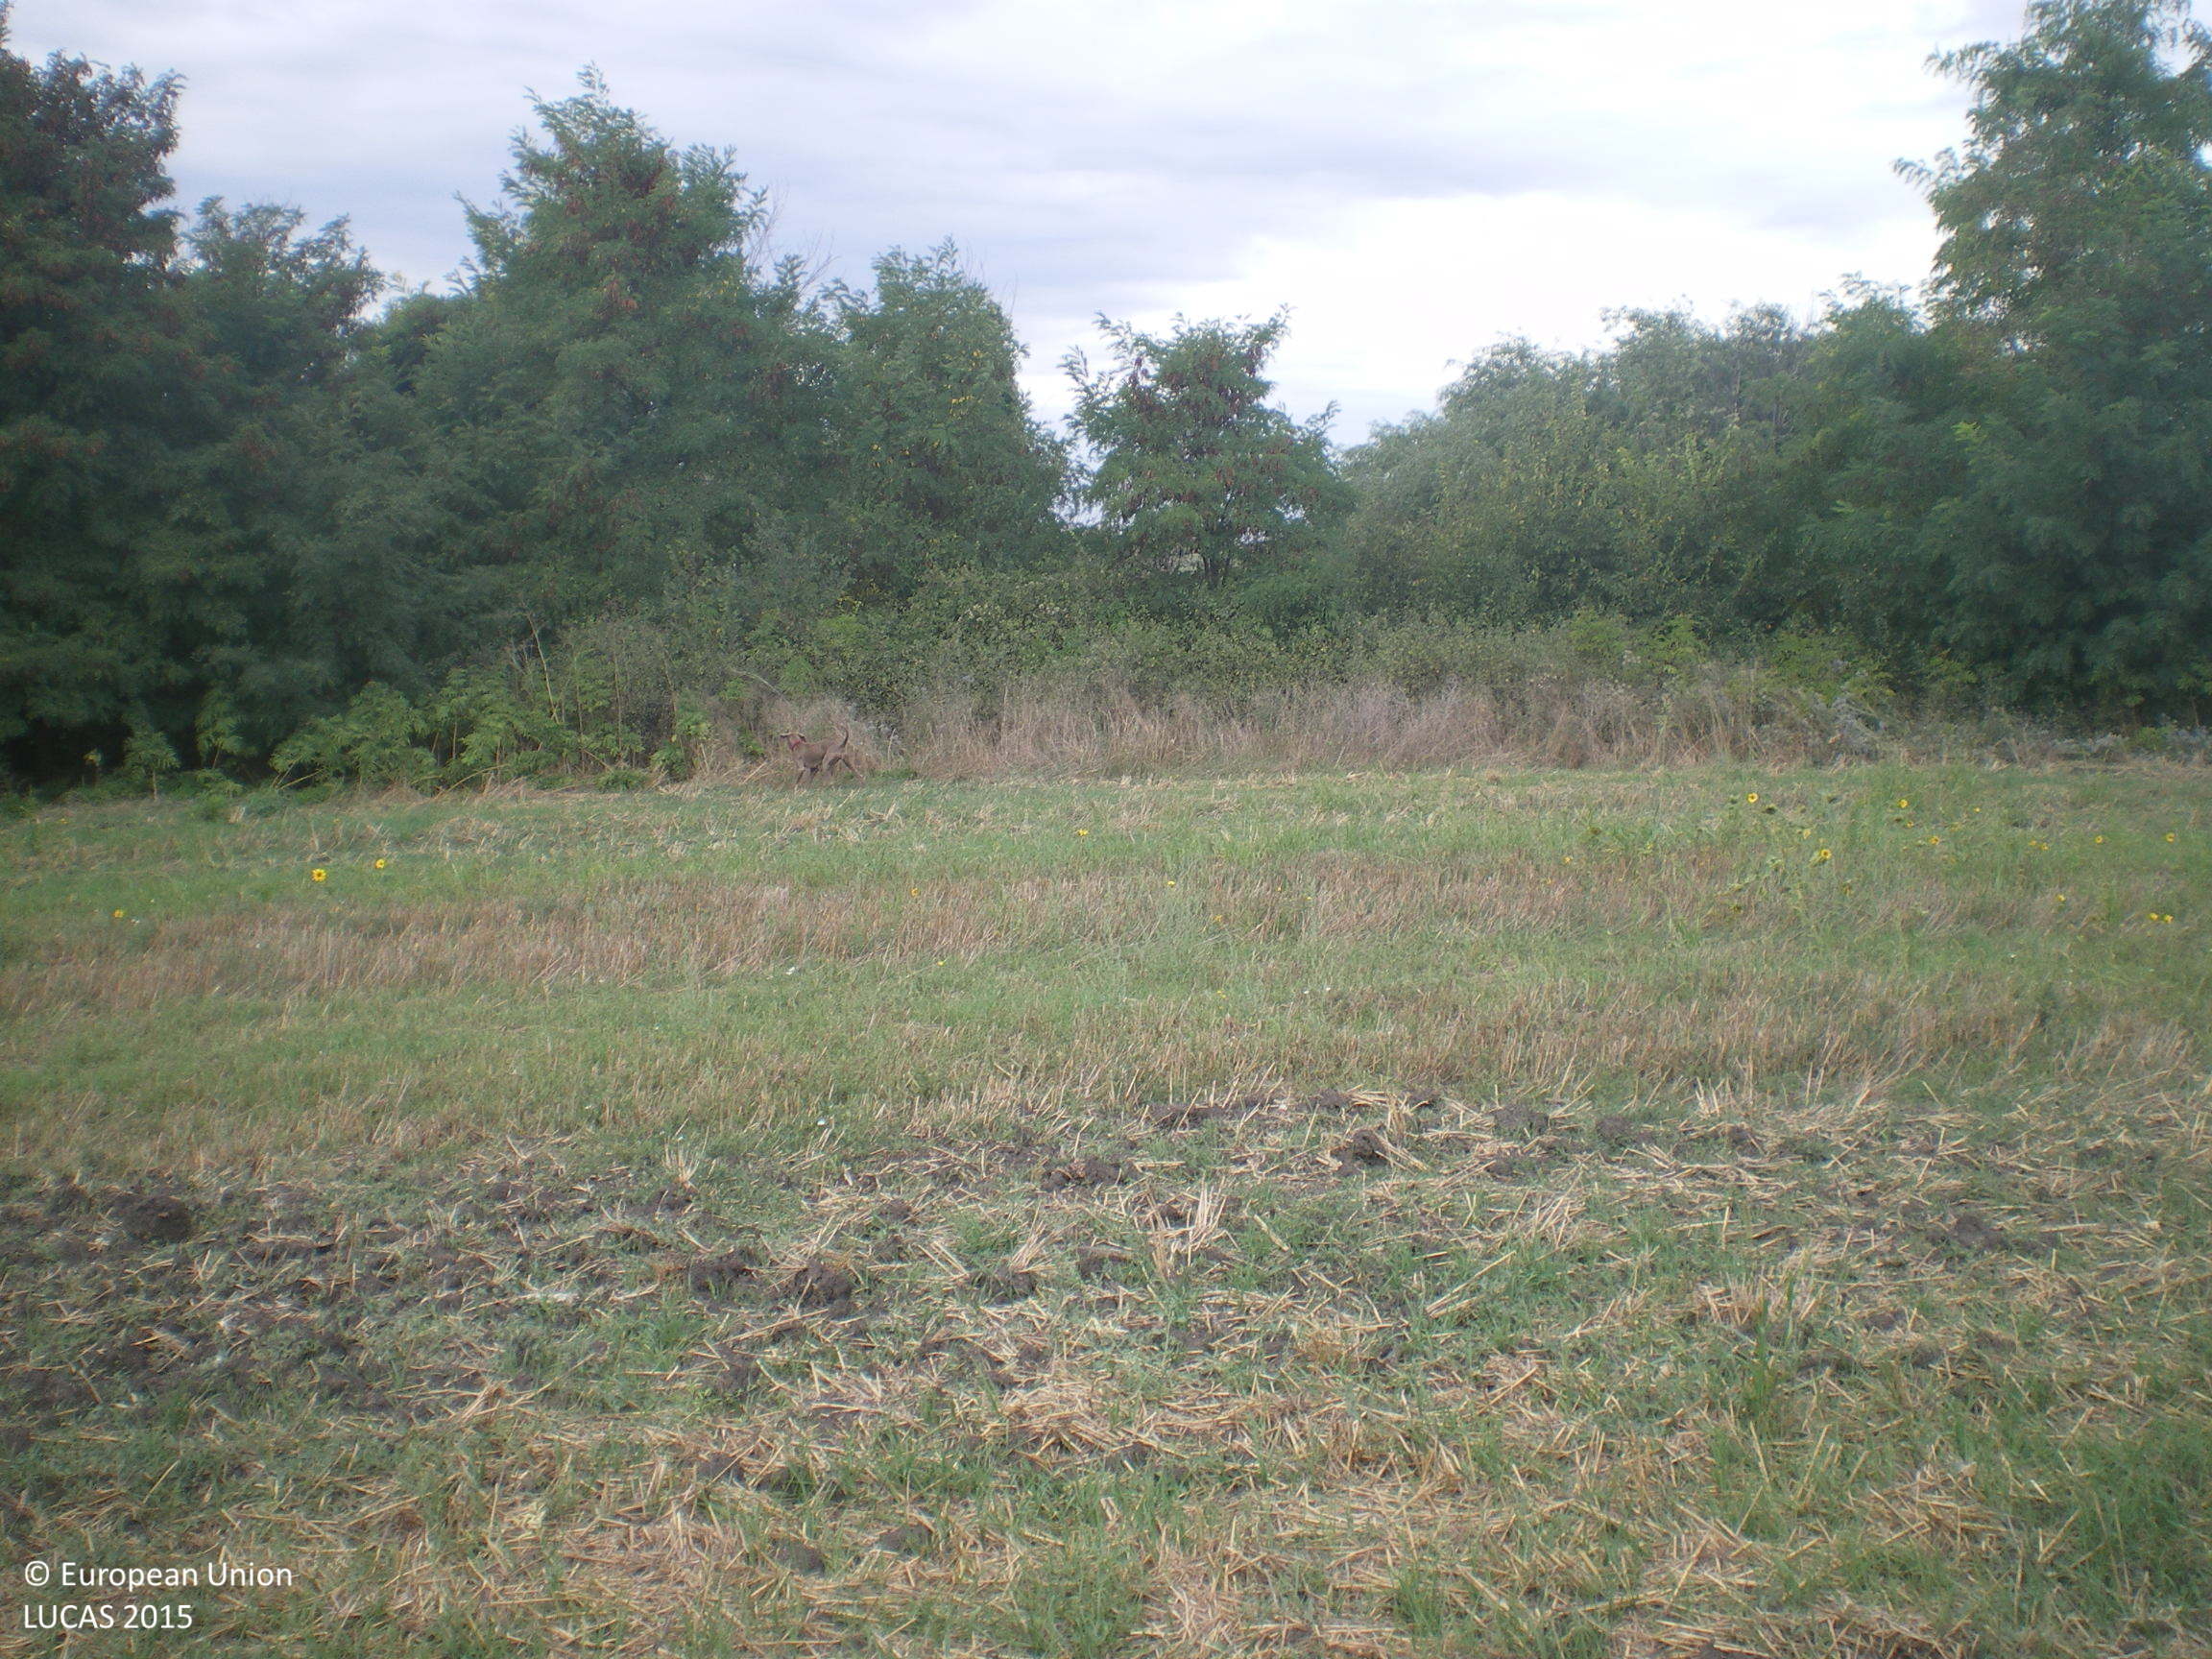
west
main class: Cropland
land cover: Common wheat
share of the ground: < 10 %
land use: Agriculture (excluding fallow land and kitchen gardens)
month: September
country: BG
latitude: 42.2456
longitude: 25.9408
